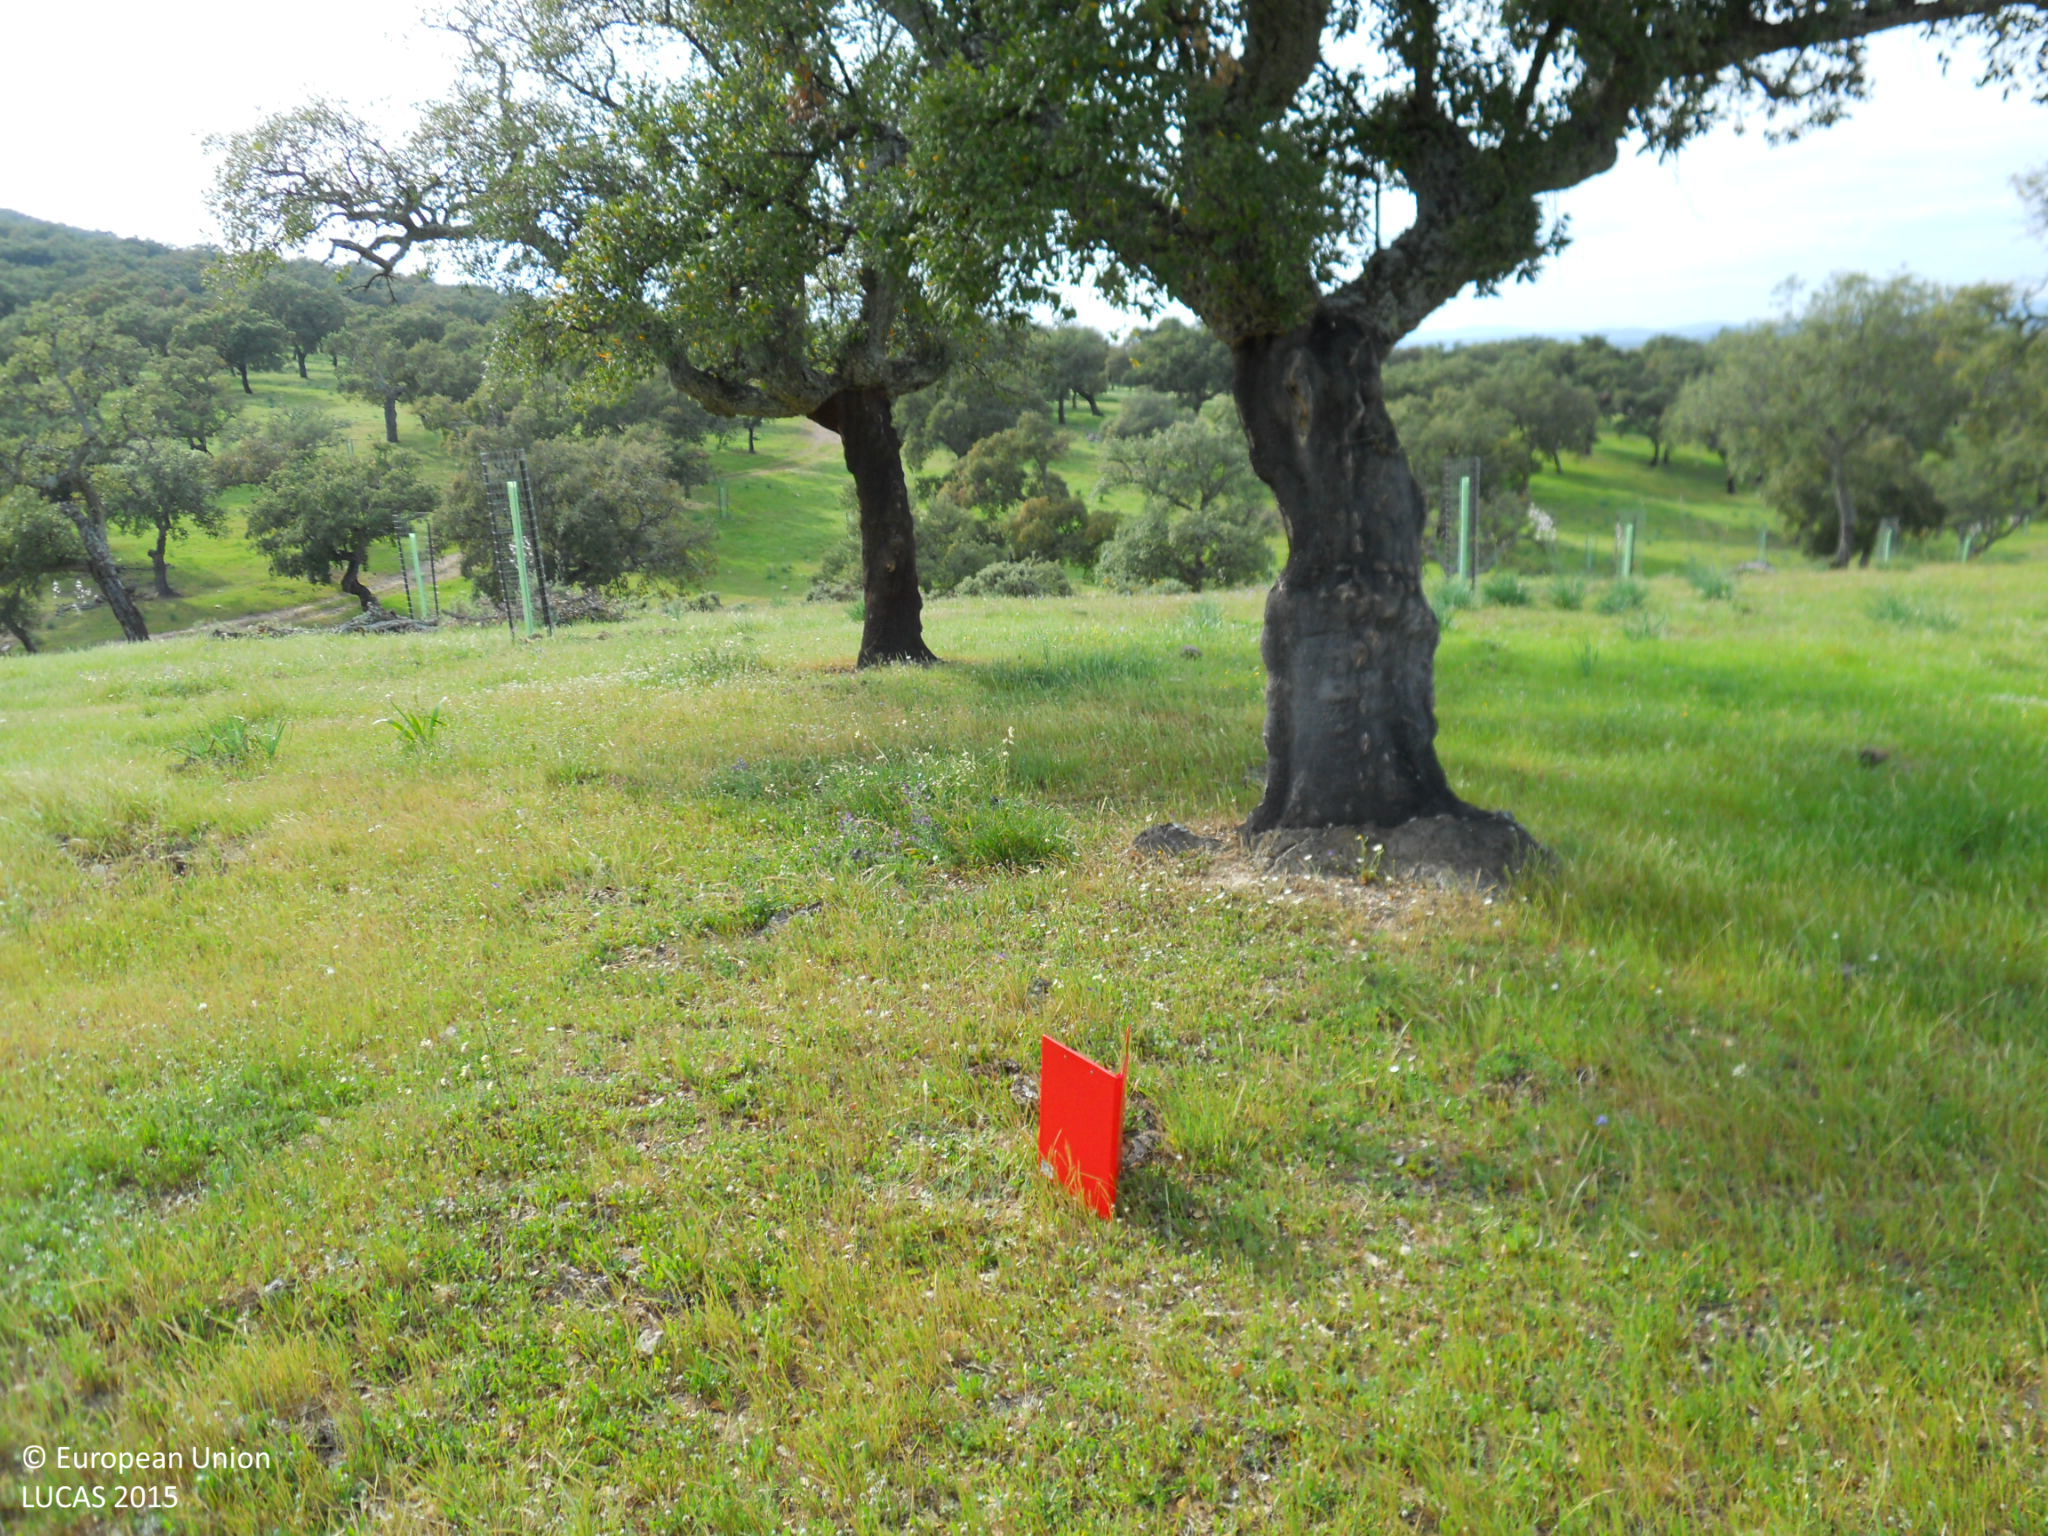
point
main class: Woodland
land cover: Broadleaved woodland
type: broadleaved evergreen forest
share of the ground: 10 - 25 %
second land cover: Grassland without tree/shrub cover
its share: > 75 %
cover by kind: herbaceous plants 80 %, broadleaved forest trees 20 %
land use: Forestry
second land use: Agriculture (excluding fallow land and kitchen gardens)
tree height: > 5 m
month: April
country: ES
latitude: 39.1979
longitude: -6.5672
